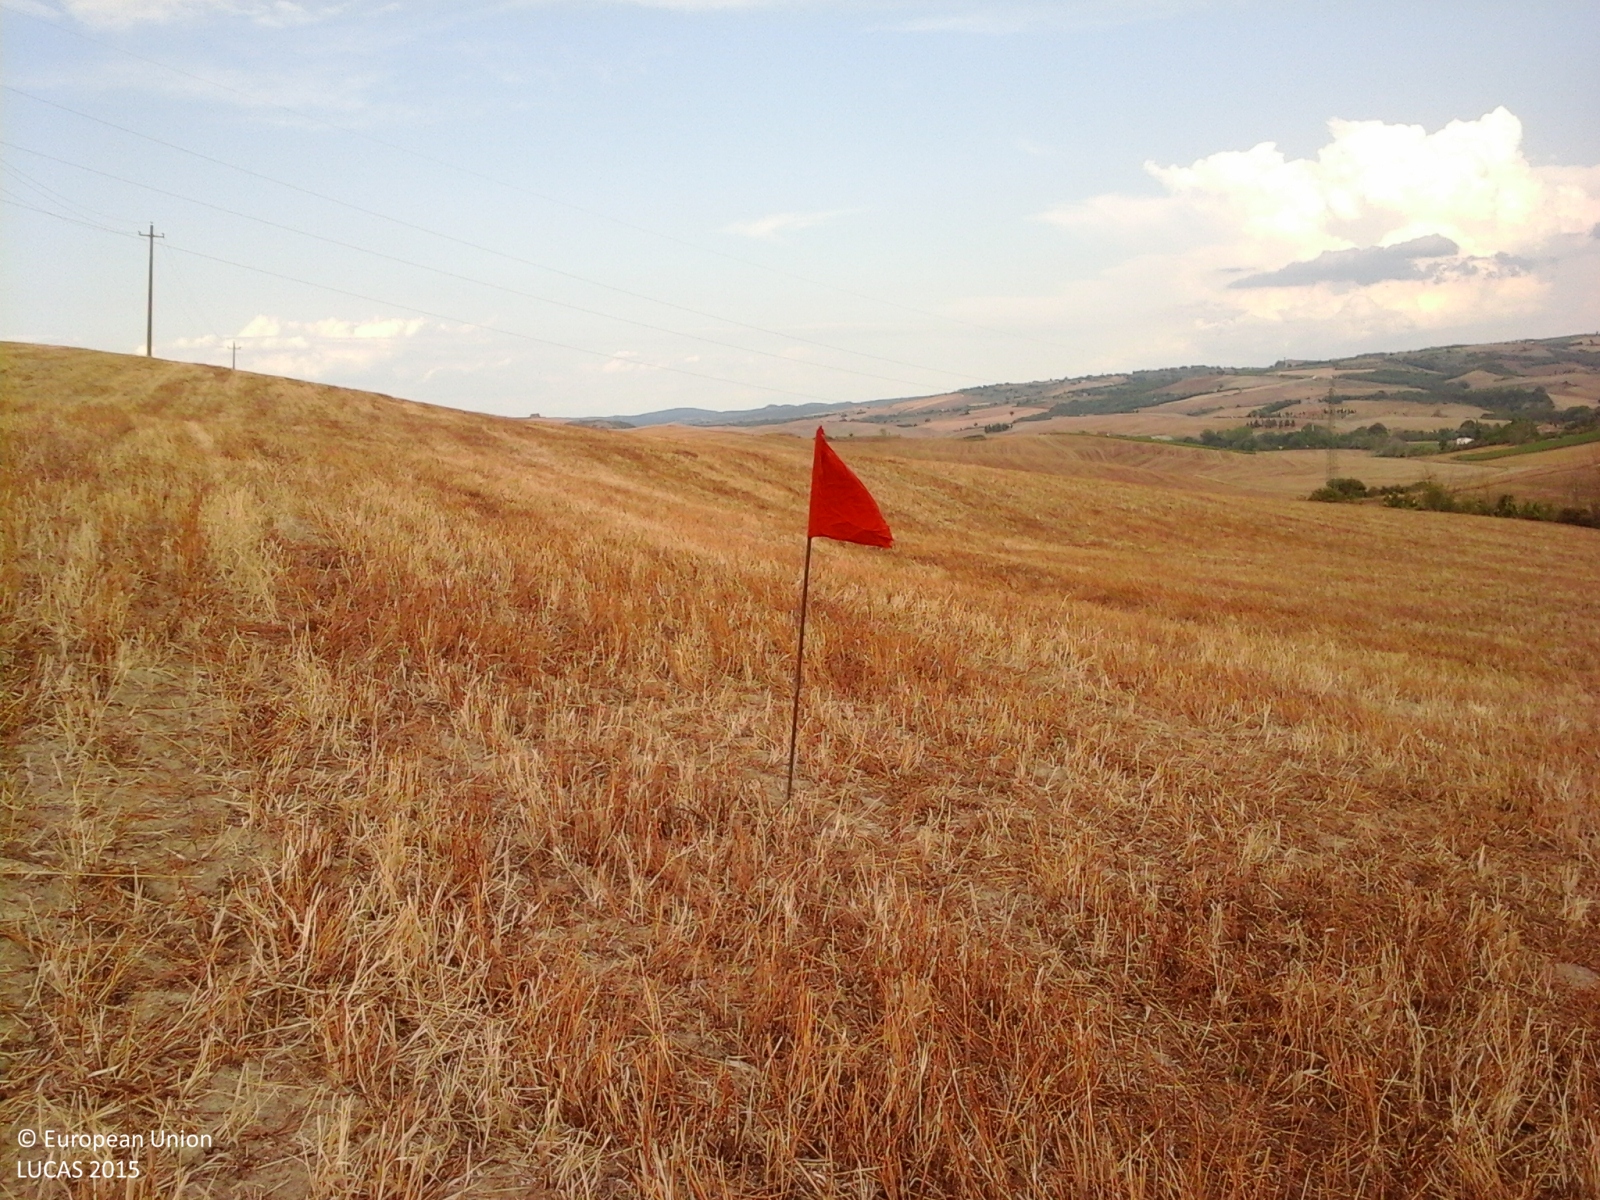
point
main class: Cropland
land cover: Temporary grasslands
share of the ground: > 75 %
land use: Agriculture (excluding fallow land and kitchen gardens)
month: July
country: IT
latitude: 43.0579
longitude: 11.5301
